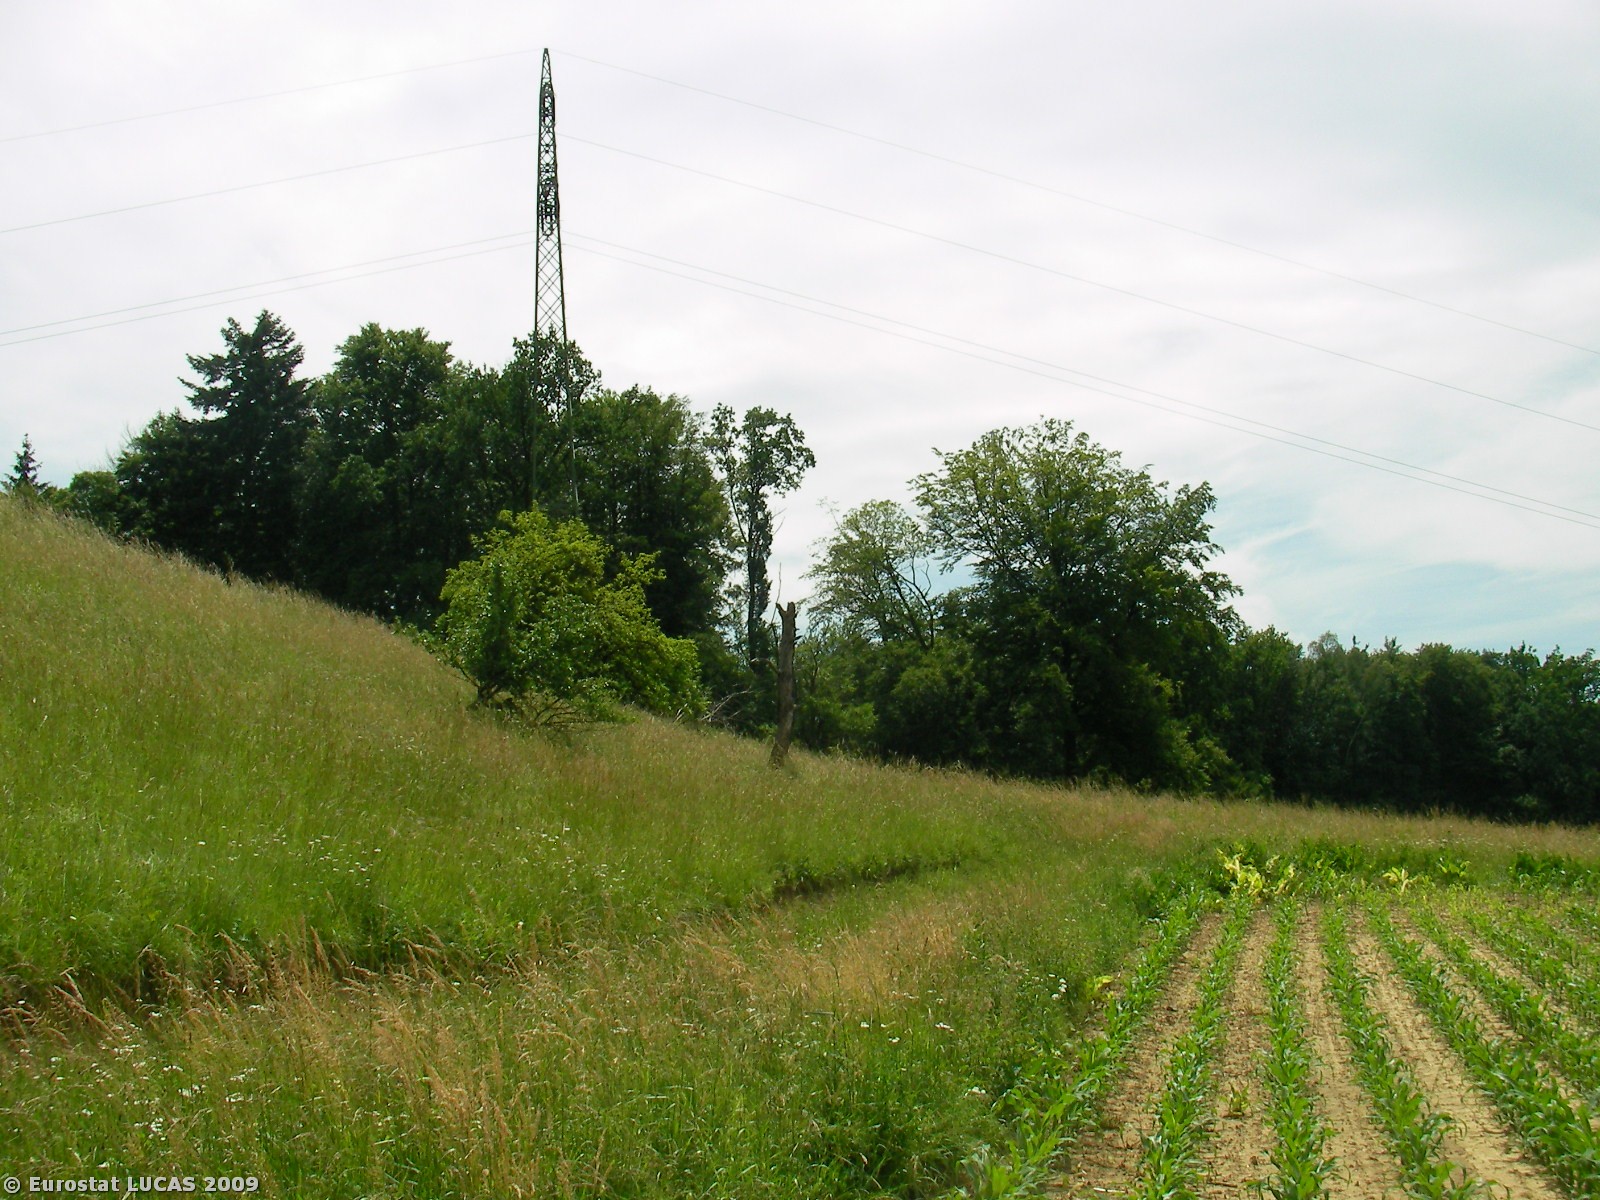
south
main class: Cropland
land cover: Maize
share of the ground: 50 - 75 %
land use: Agriculture (excluding fallow land and kitchen gardens)
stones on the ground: < 10 %
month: June
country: AT
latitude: 46.9109
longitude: 15.5535
